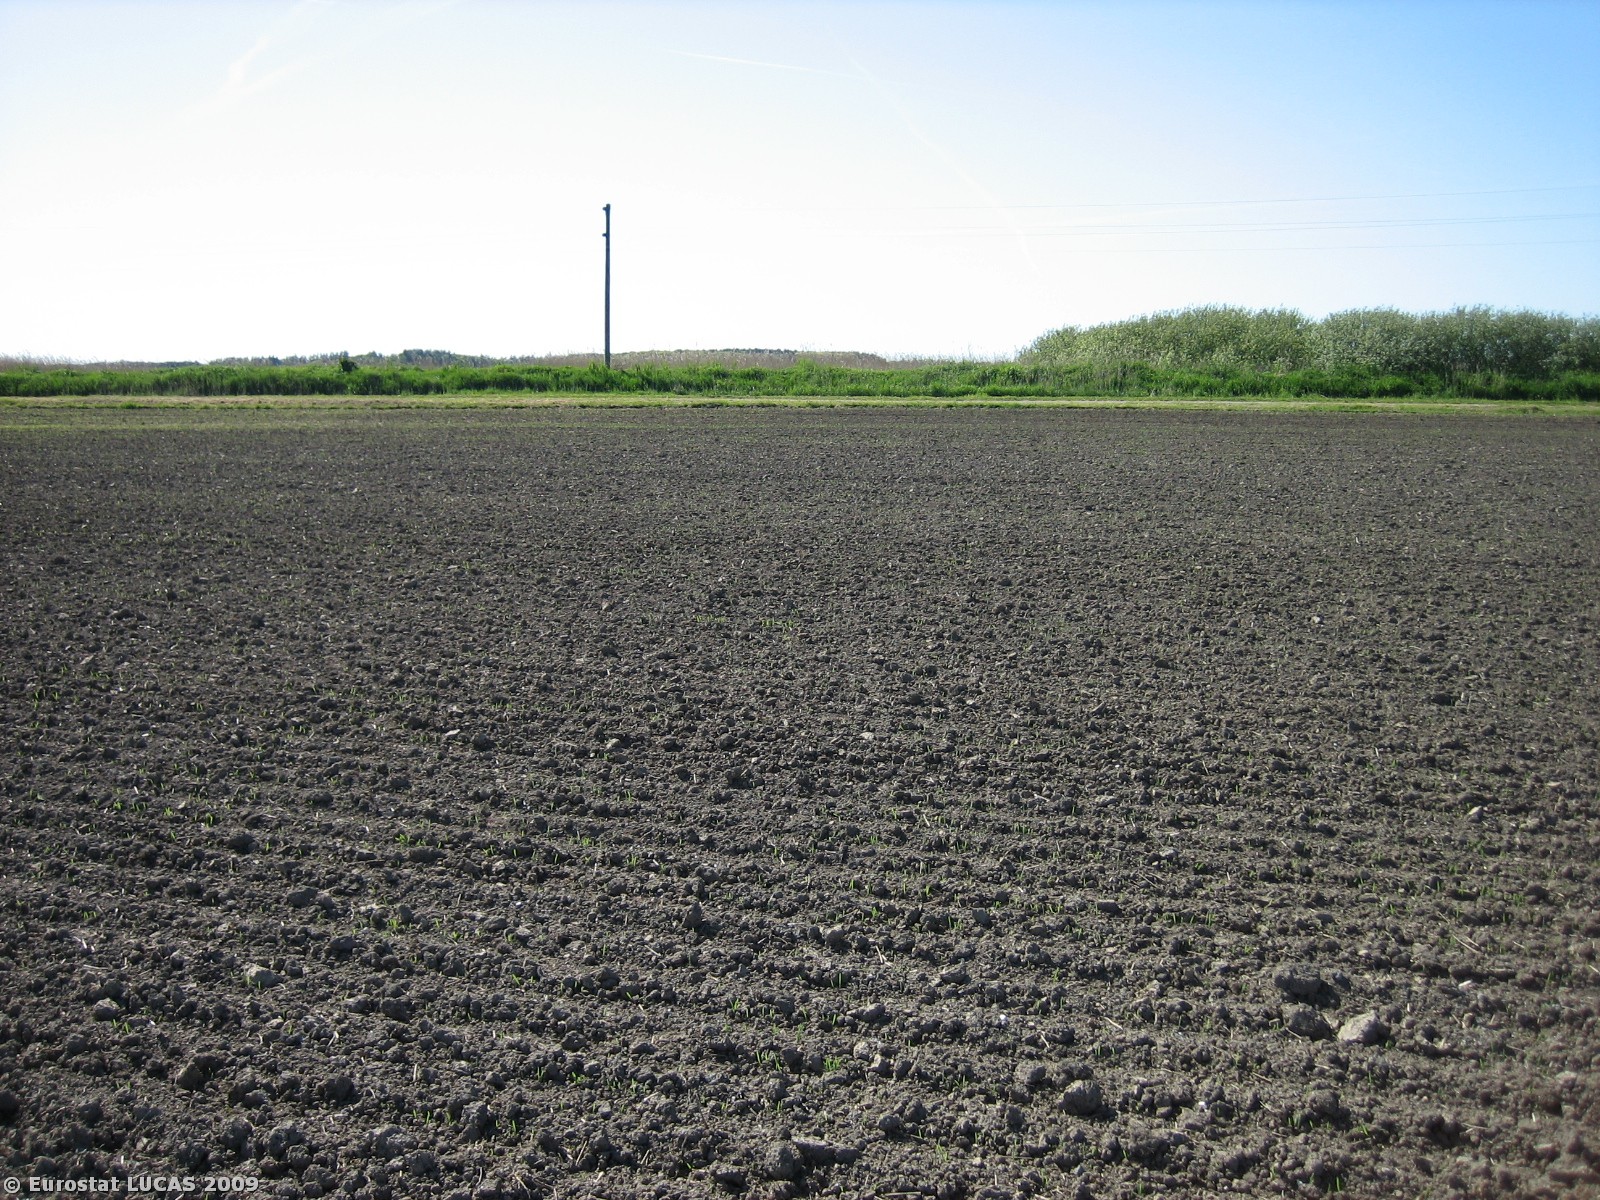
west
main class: Cropland
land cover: Barley
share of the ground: < 10 %
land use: Agriculture (excluding fallow land and kitchen gardens)
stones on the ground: < 10 %
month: May
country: DK
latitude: 56.2472
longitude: 8.2107
